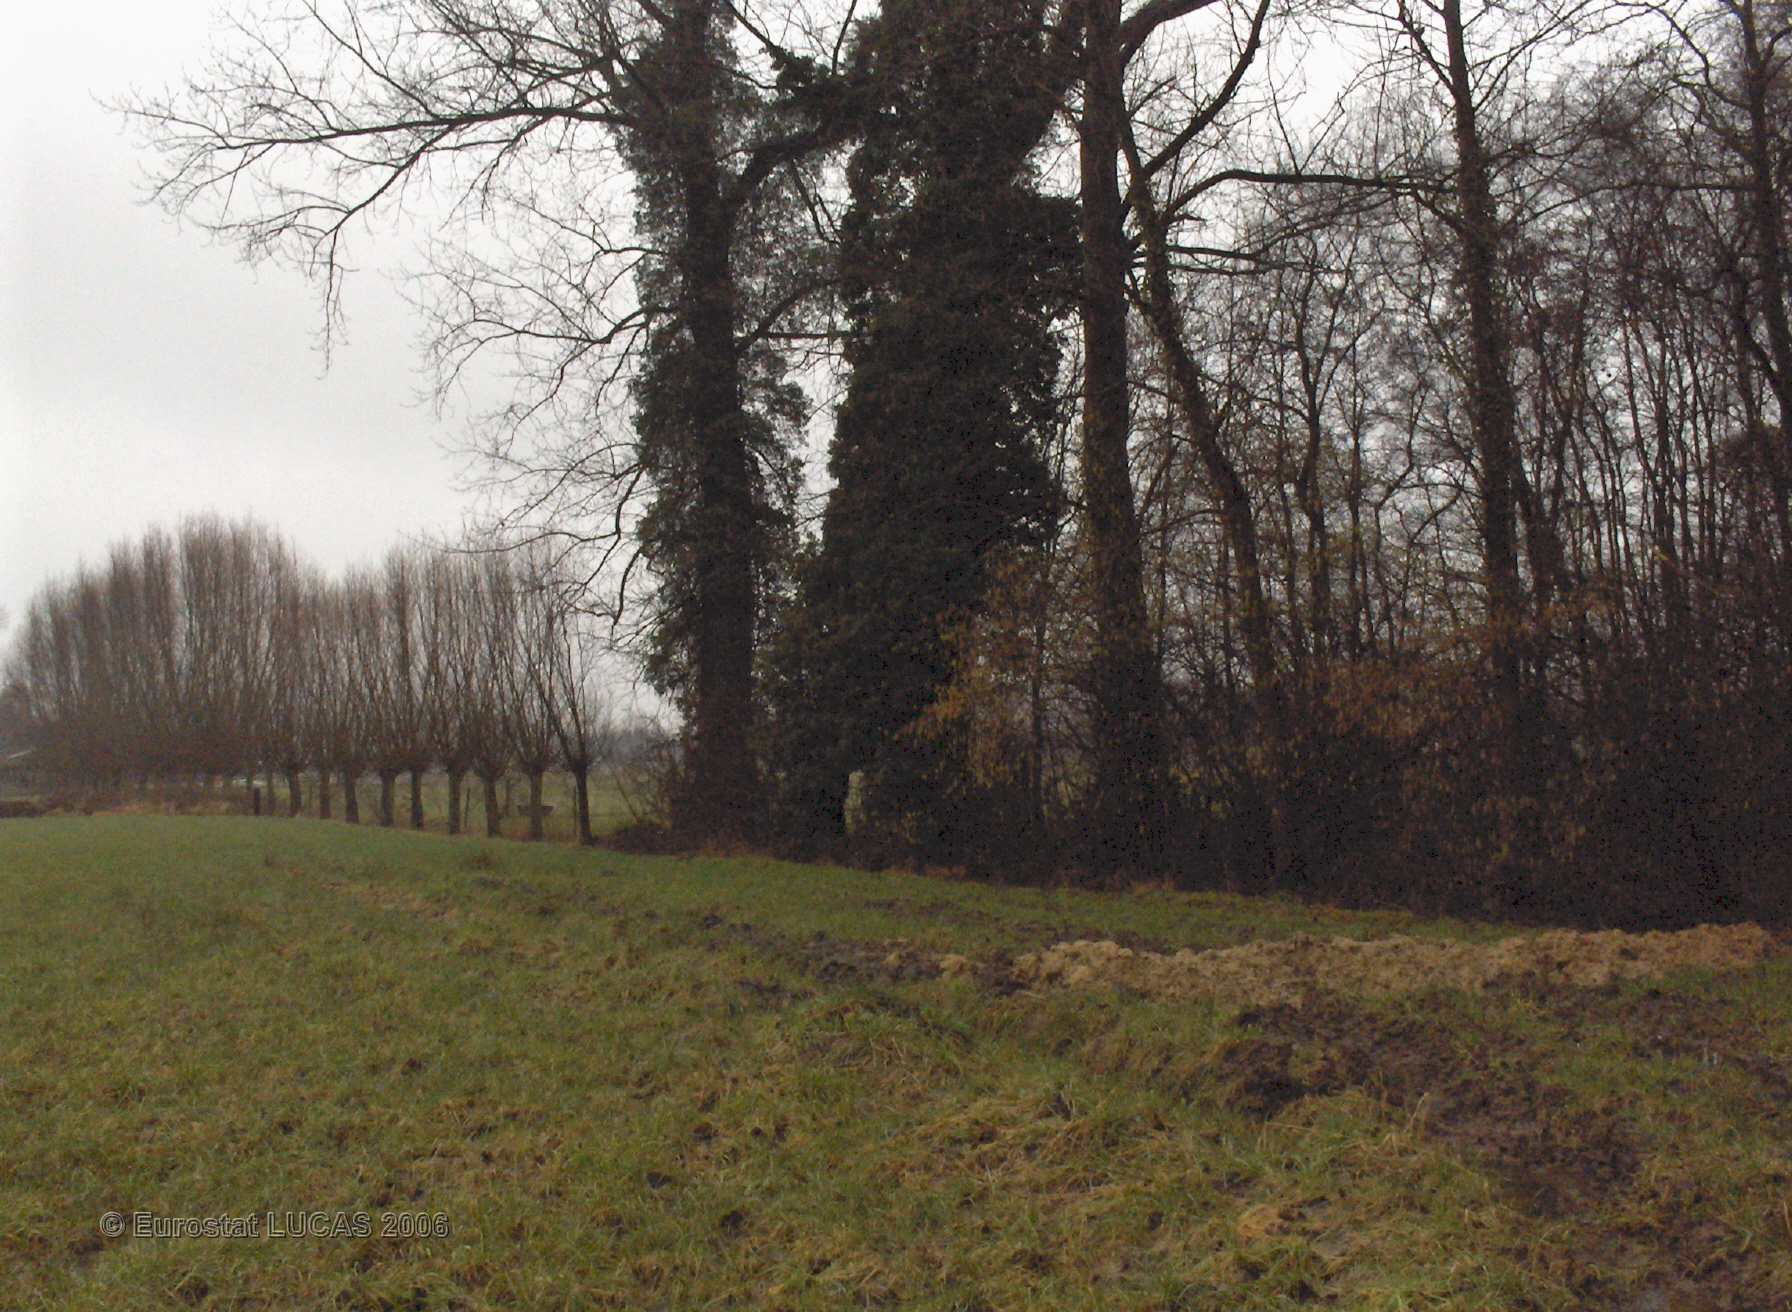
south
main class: Grassland
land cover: Grassland without tree/shrub cover
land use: Agriculture (excluding fallow land and kitchen gardens)
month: March
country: BE
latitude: 51.0954
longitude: 4.4697
